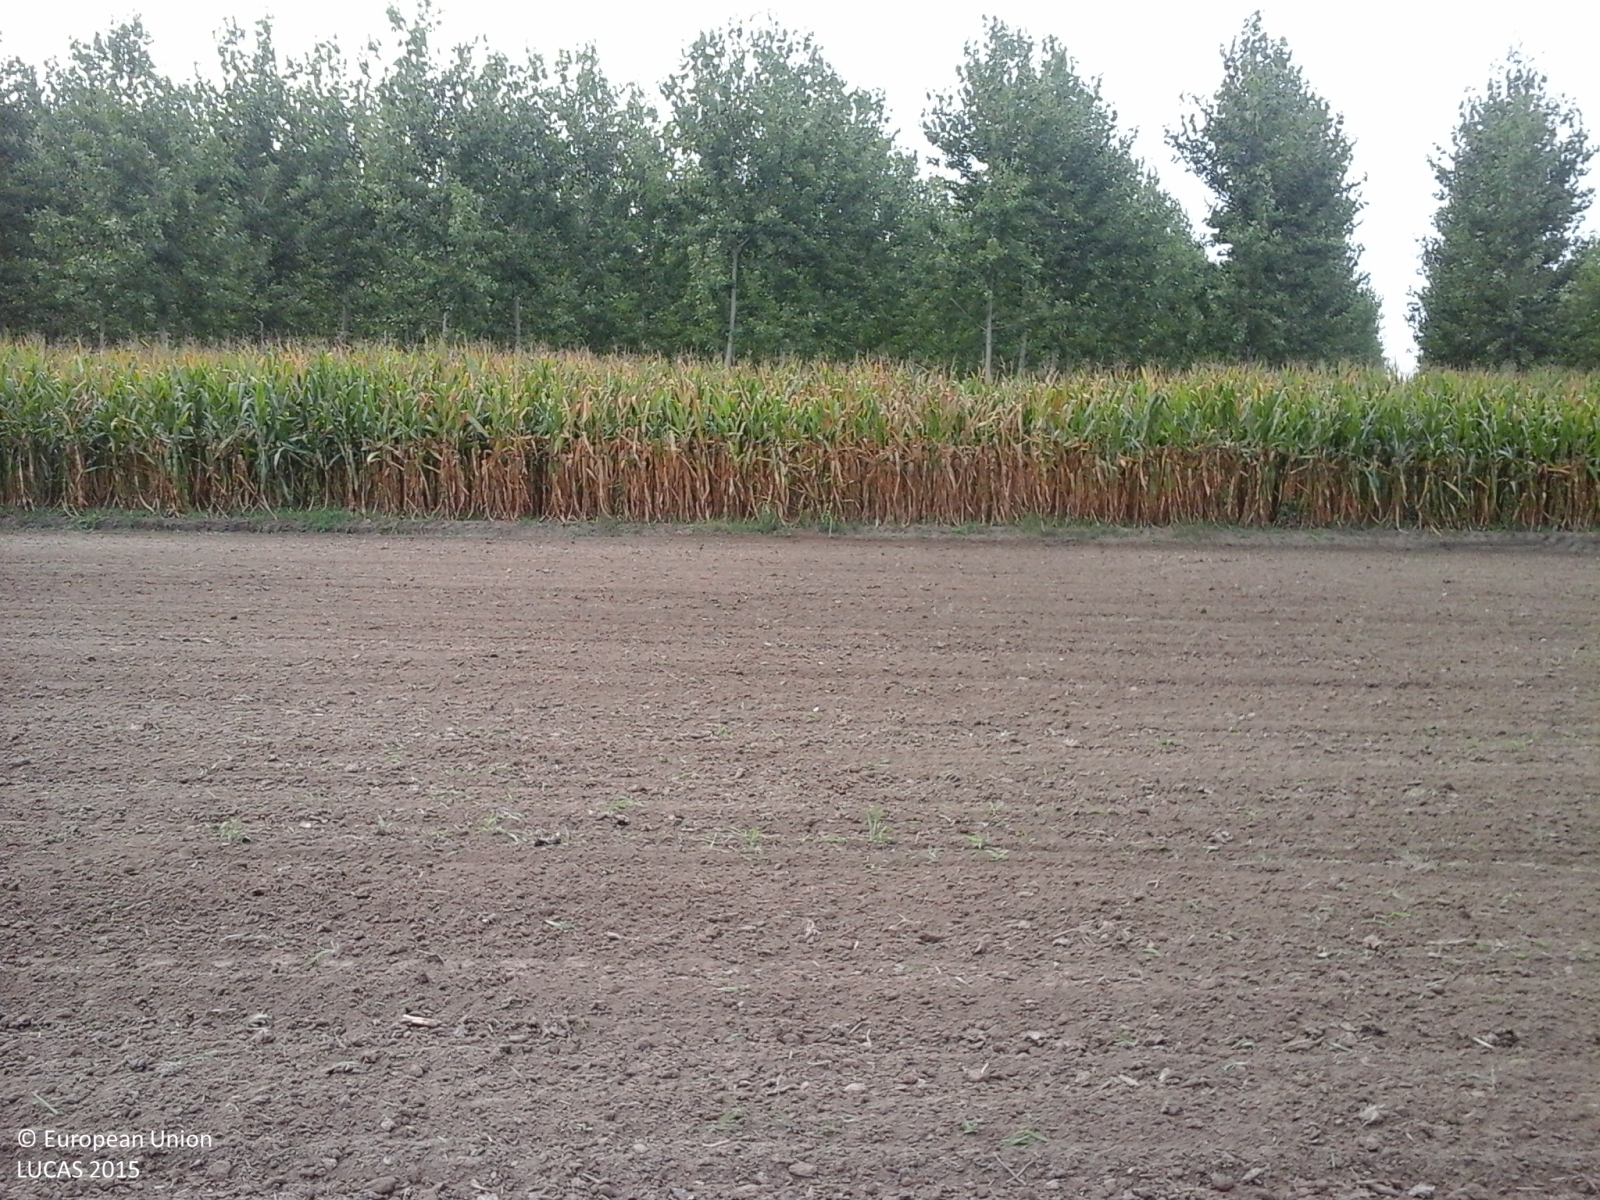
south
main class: Cropland
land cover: Common wheat
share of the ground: < 10 %
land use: Agriculture (excluding fallow land and kitchen gardens)
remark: Harvested field
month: August
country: IT
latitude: 44.6306
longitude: 7.6475
